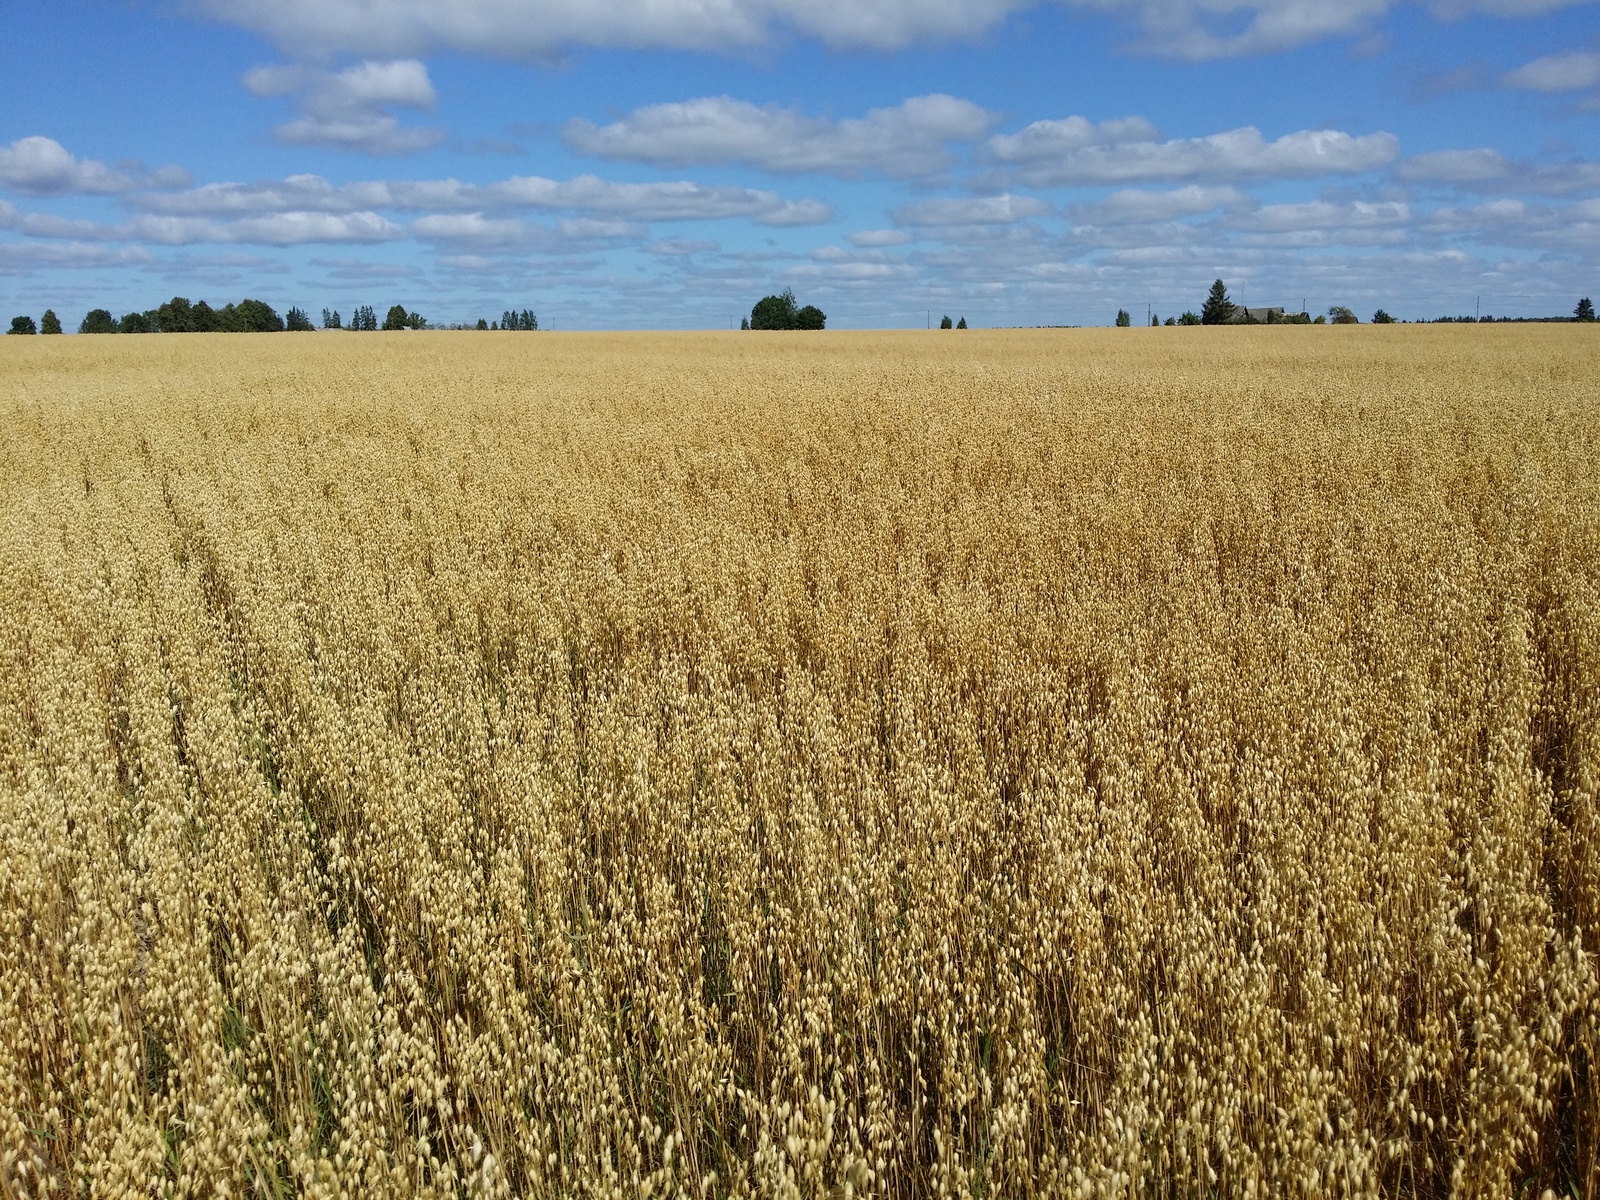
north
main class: Cropland
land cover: Oats
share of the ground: > 75 %
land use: Agriculture (excluding fallow land and kitchen gardens)
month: August
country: LV
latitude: 57.2422
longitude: 27.7657
